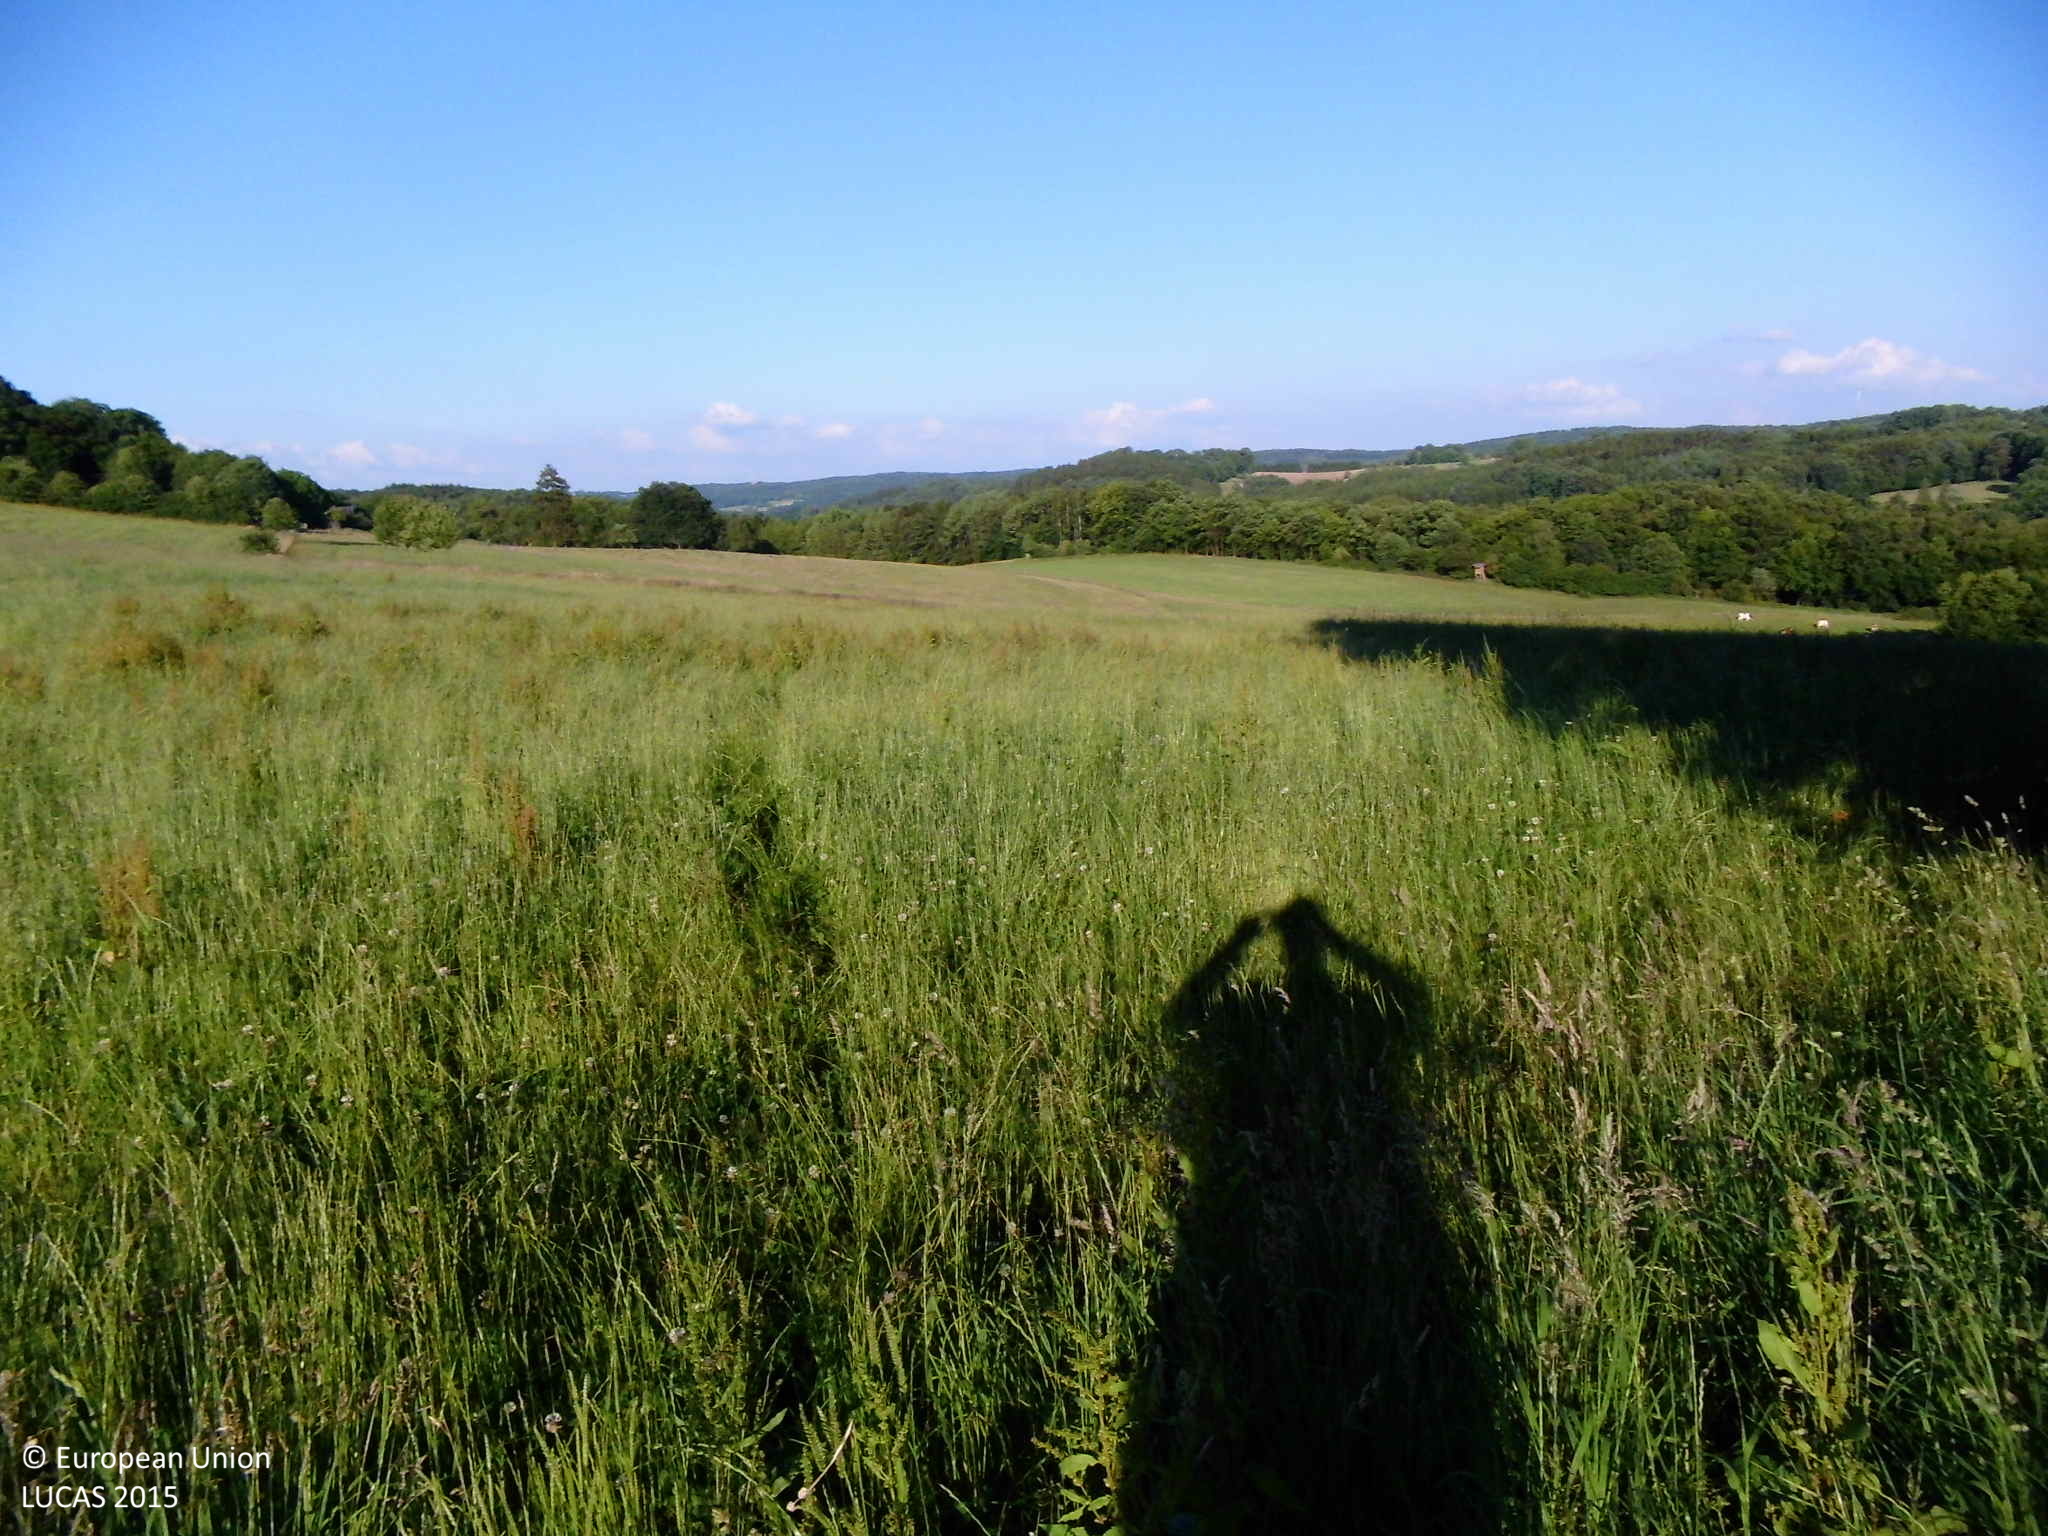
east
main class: Grassland
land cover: Grassland without tree/shrub cover
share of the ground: > 75 %
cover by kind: herbaceous plants 100 %
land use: Agriculture (excluding fallow land and kitchen gardens)
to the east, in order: Grassland without tree/shrub cover; Tracks; Grassland without tree/shrub cover; Tracks; Grassland without tree/shrub cover
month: June
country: DE
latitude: 50.8587
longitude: 7.5141
